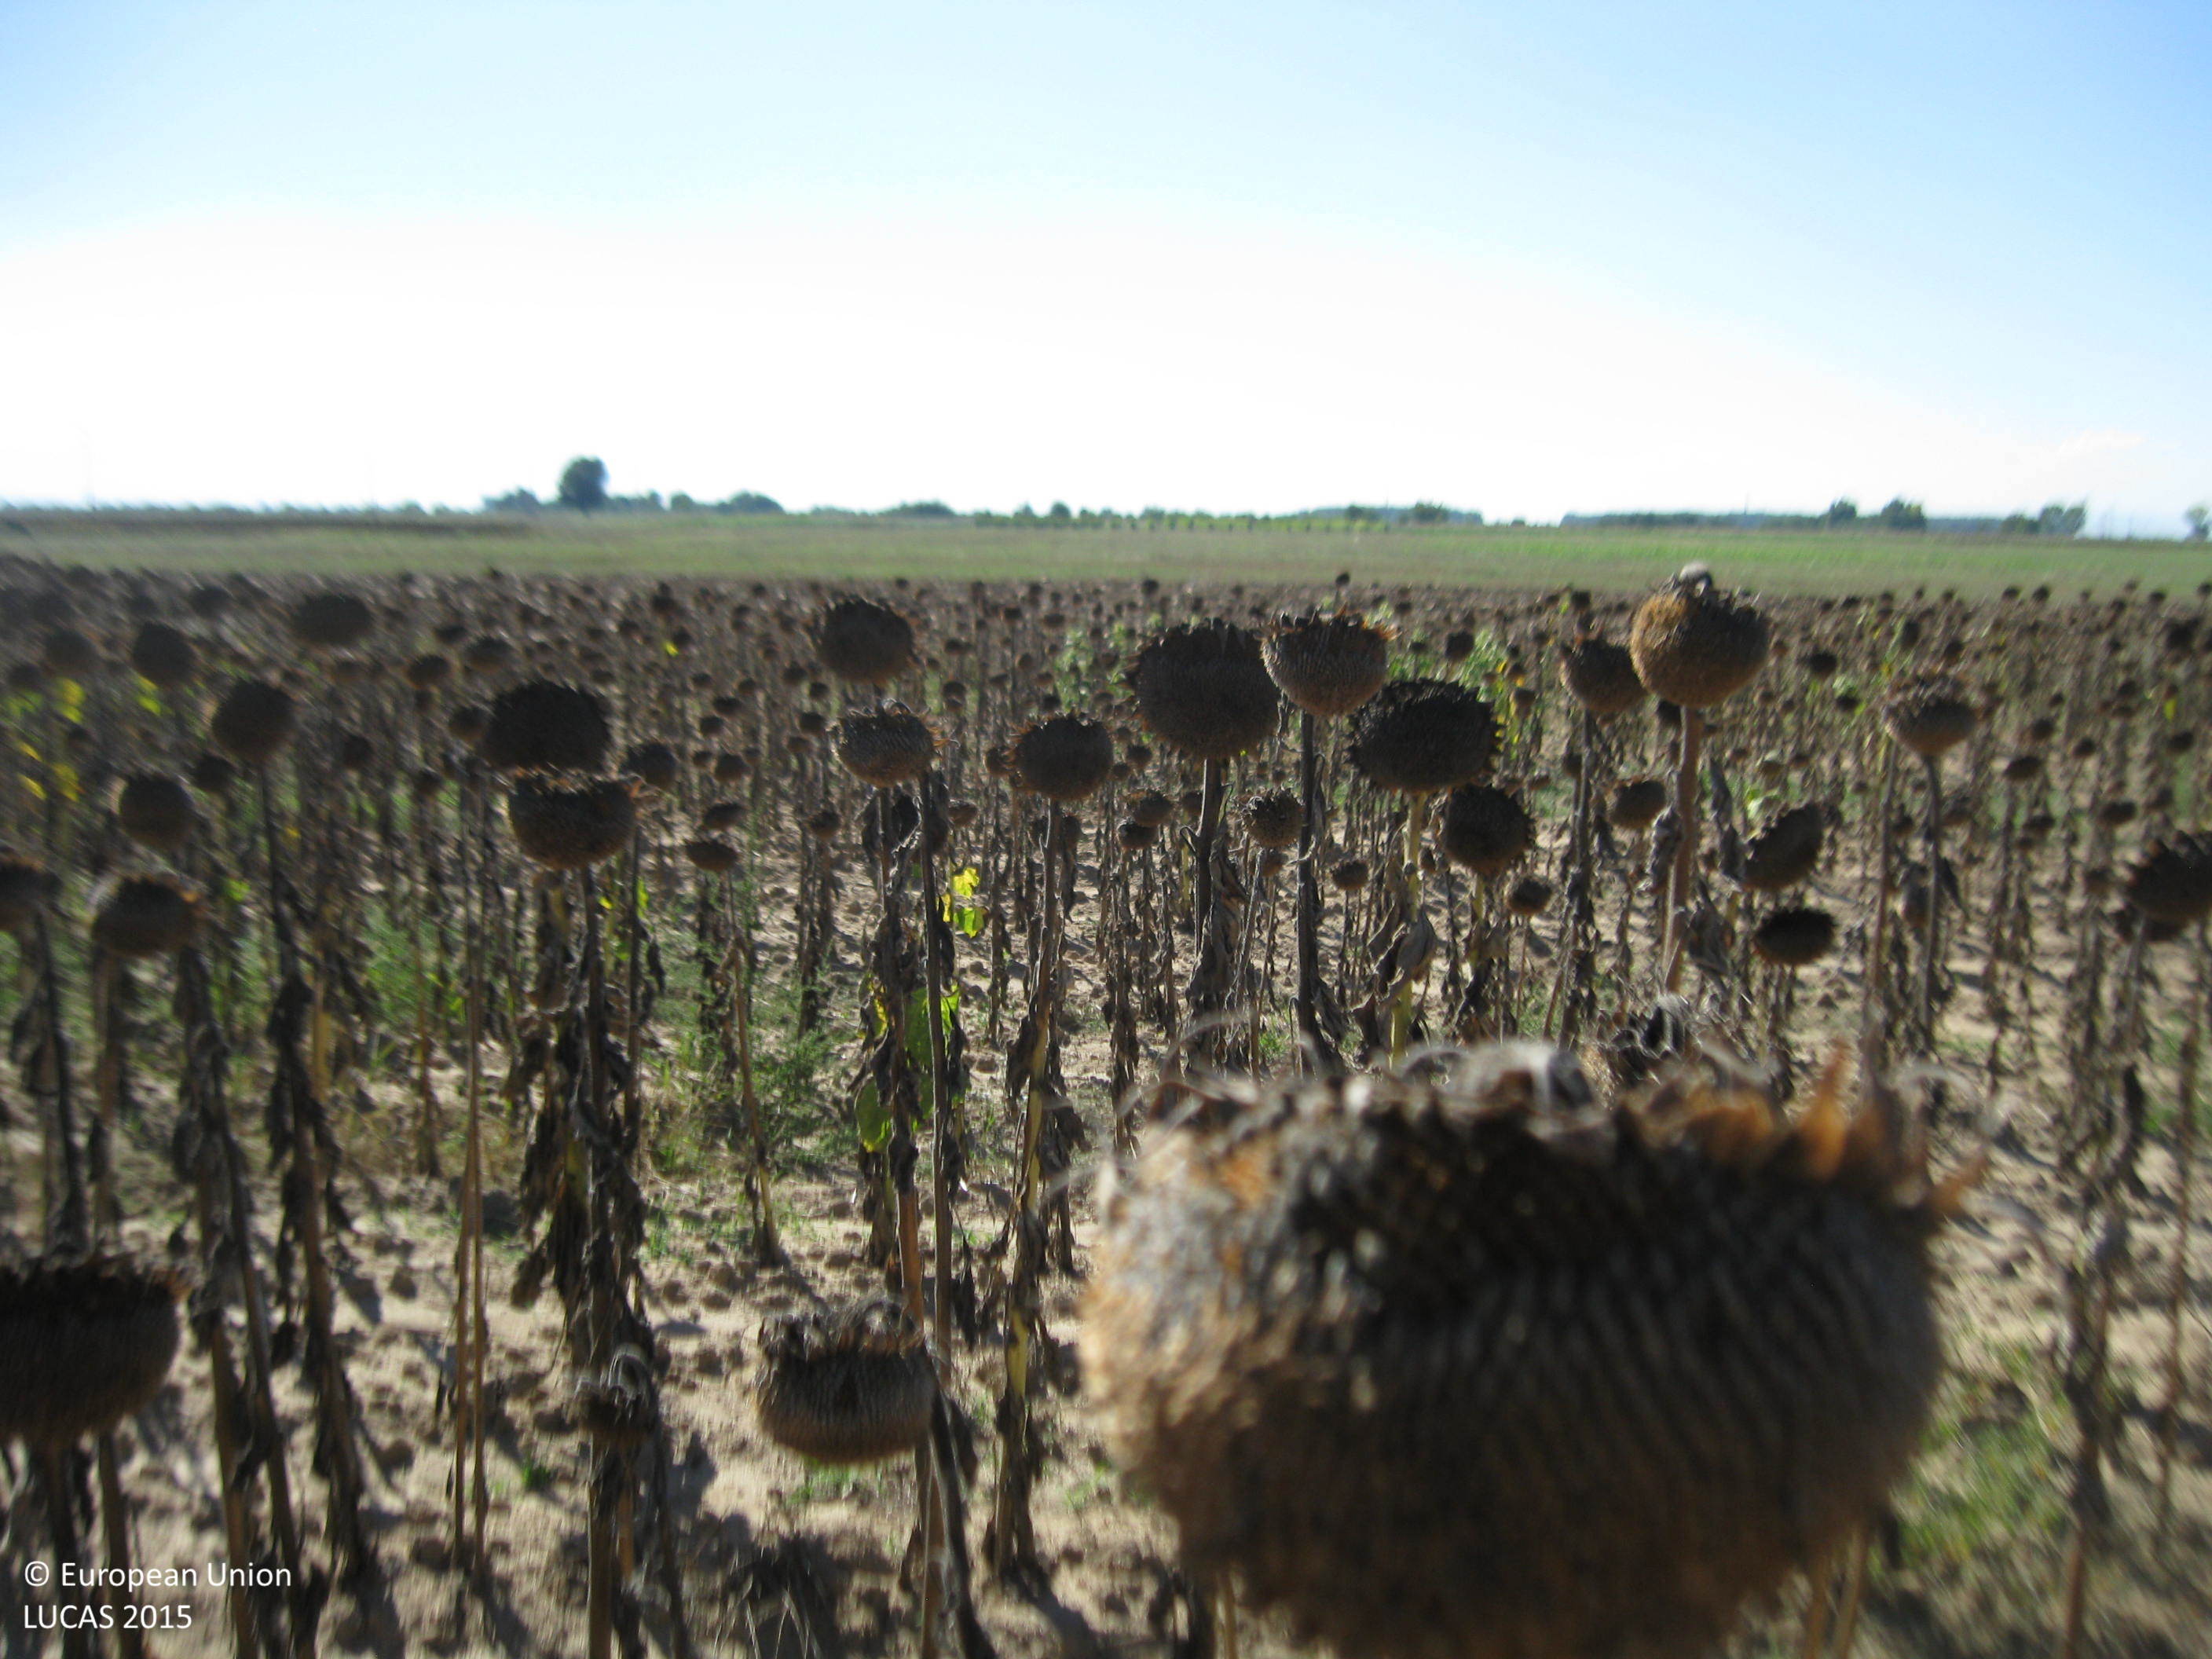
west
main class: Cropland
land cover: Sunflower
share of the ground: > 75 %
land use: Agriculture (excluding fallow land and kitchen gardens)
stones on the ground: < 10 %
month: September
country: BG
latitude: 42.2378
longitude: 24.6777
